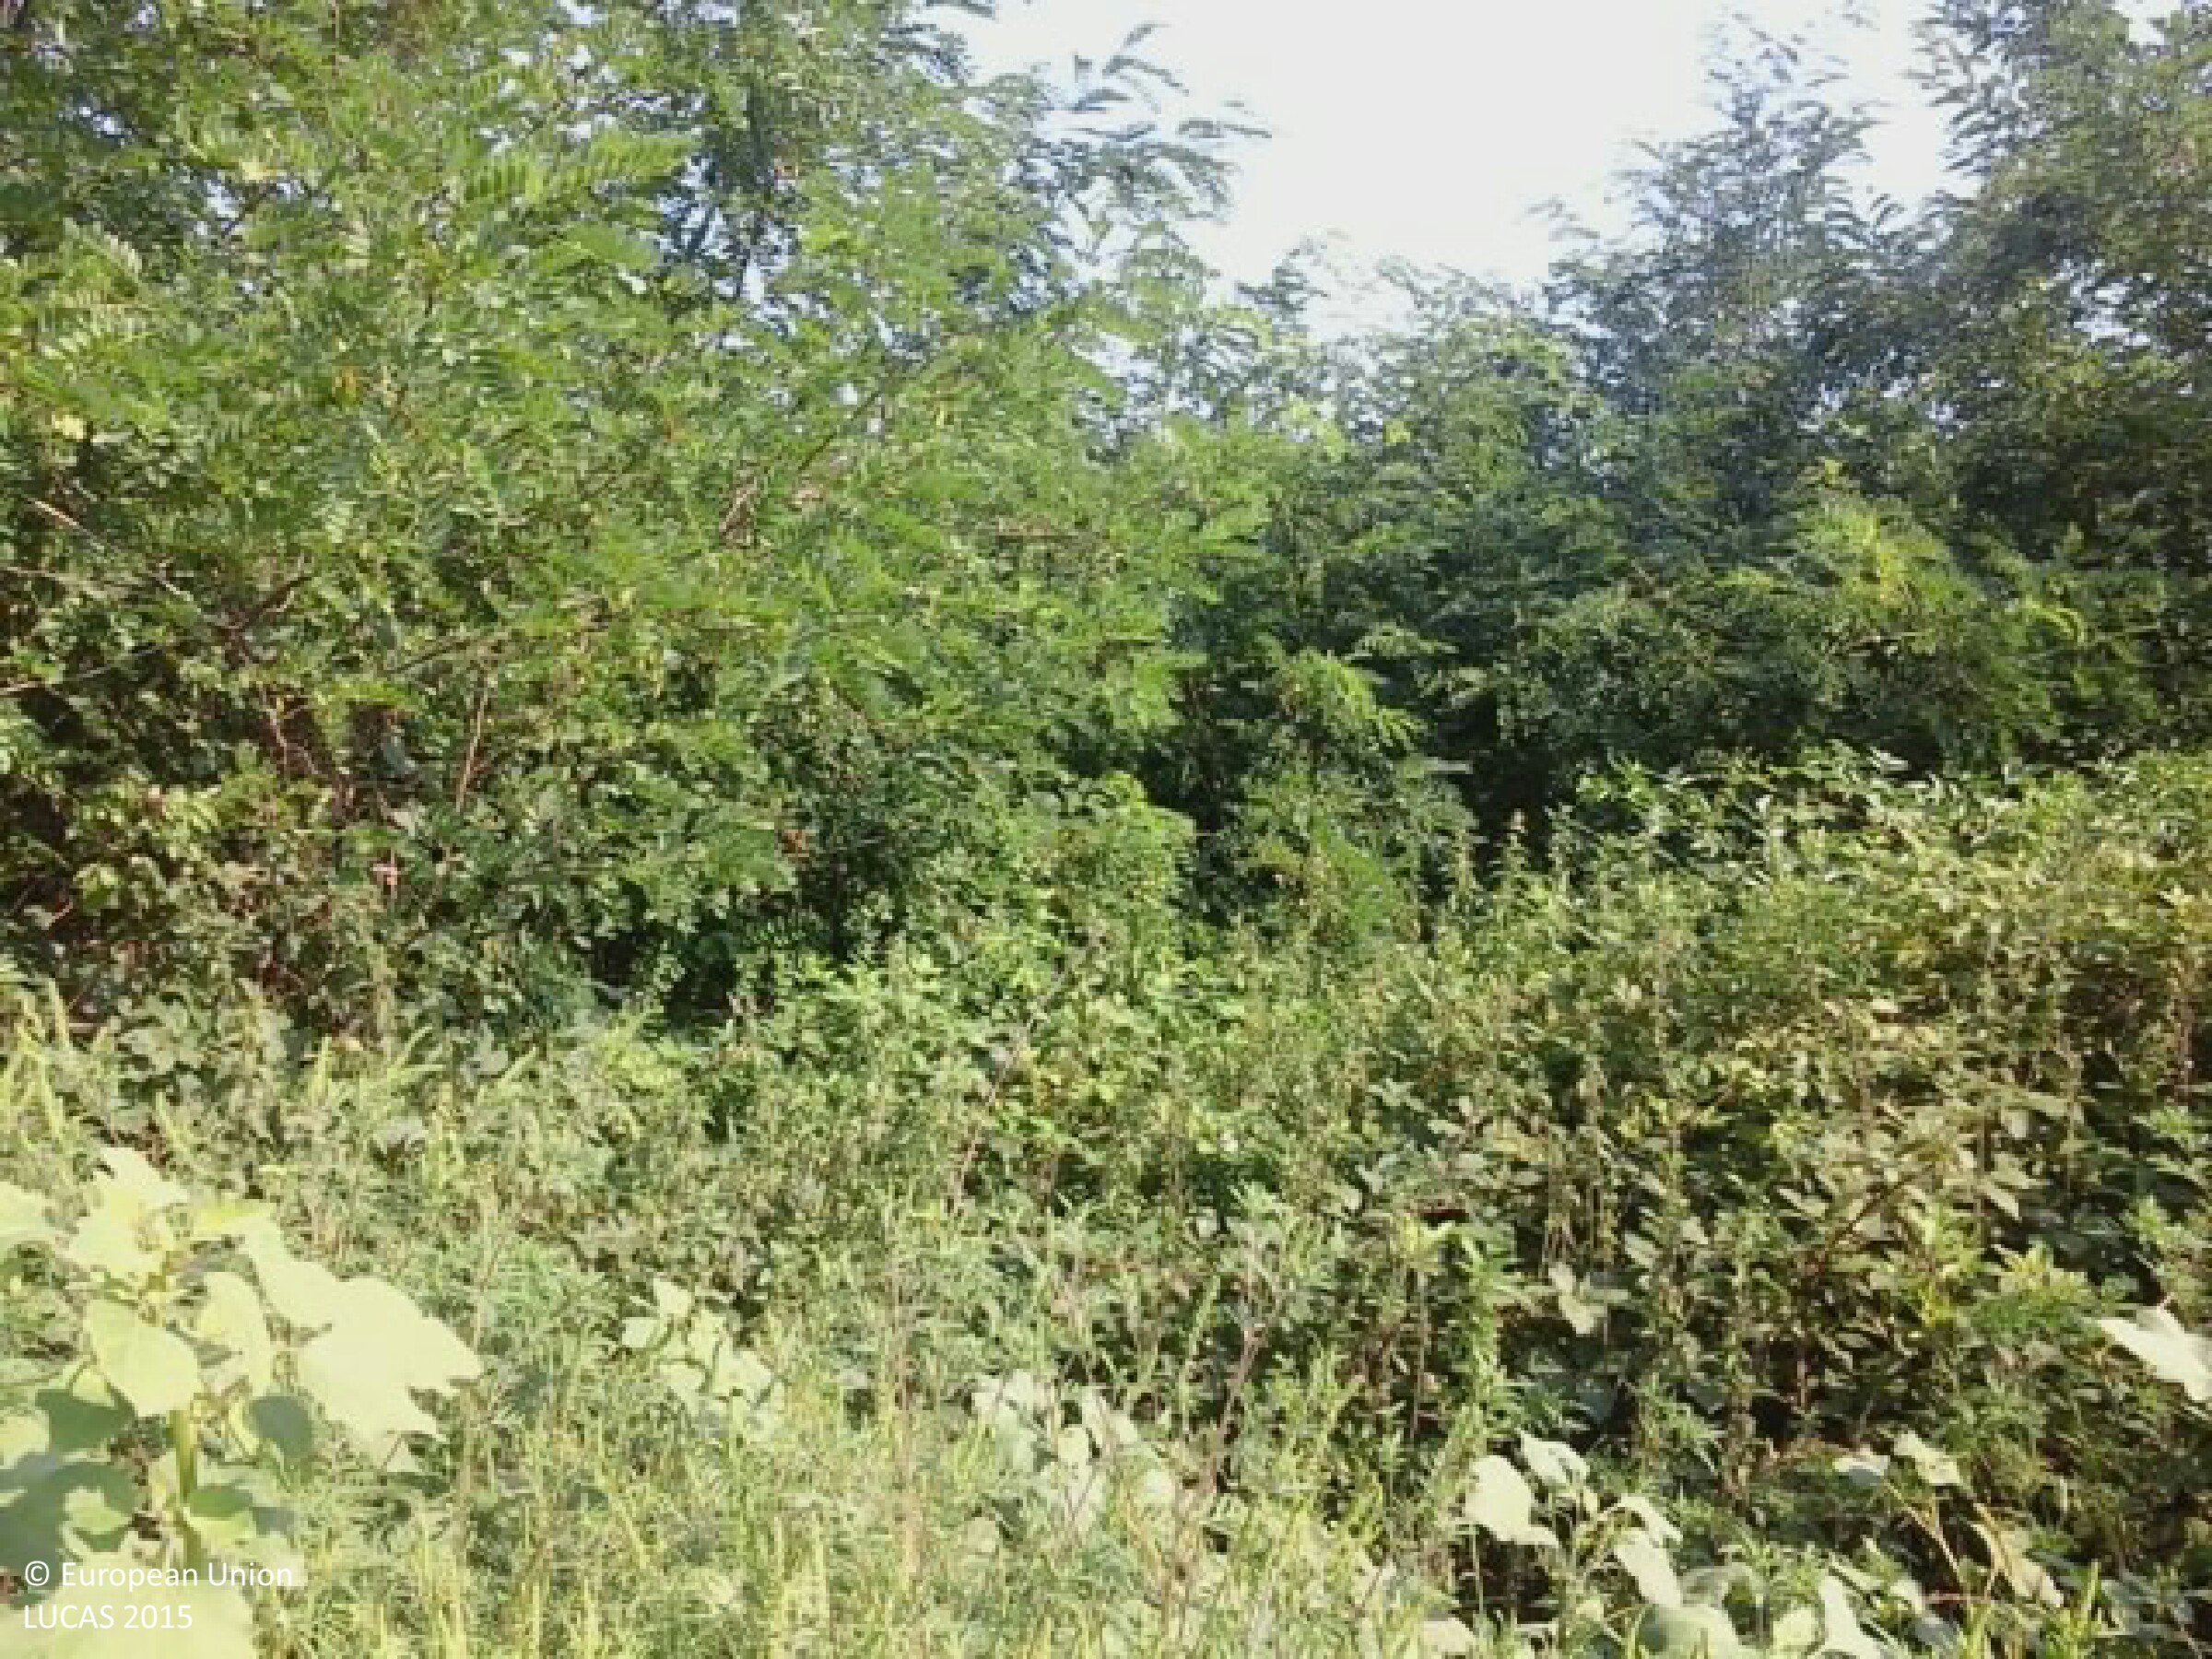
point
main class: Woodland
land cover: Broadleaved woodland
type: exotic forest
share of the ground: > 75 %
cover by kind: shrubs 60 %, broadleaved forest trees 40 %
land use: Abandoned areas
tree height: < 5 m
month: August
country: HU
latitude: 46.2954
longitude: 18.3559
